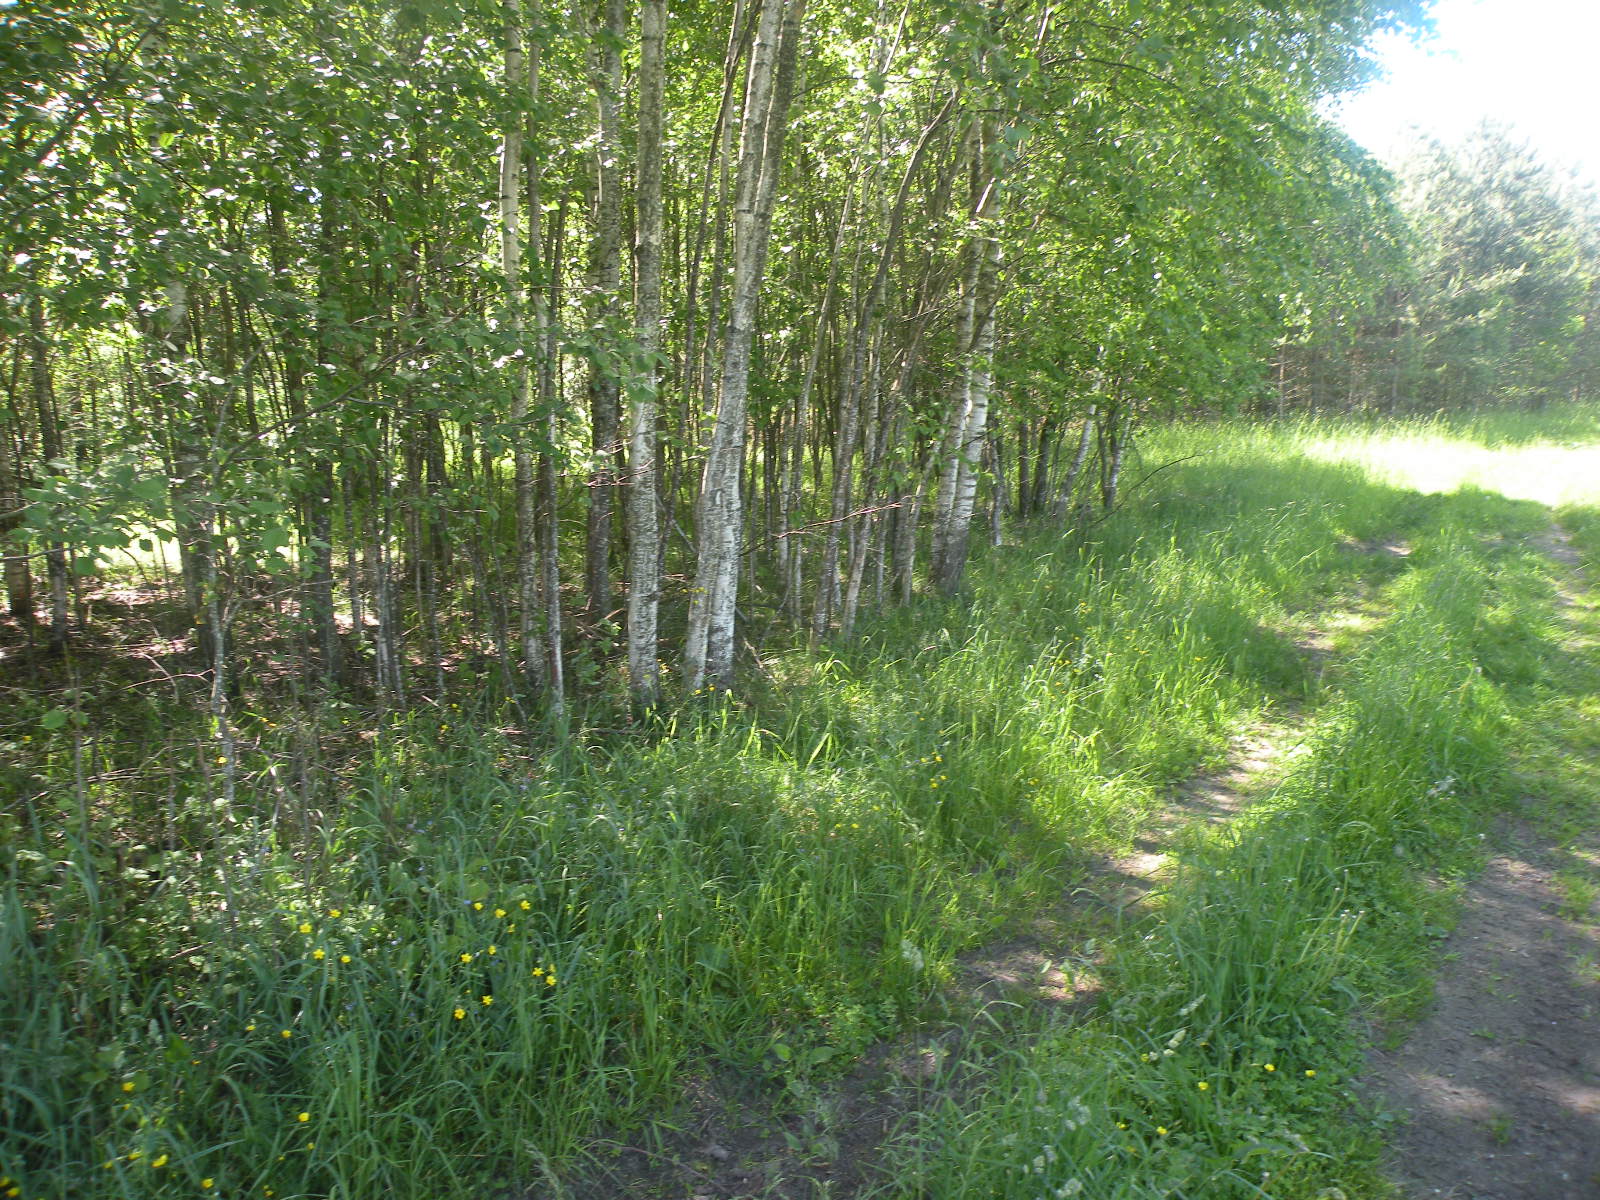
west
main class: Grassland
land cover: Grassland without tree/shrub cover
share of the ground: > 75 %
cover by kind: herbaceous plants 100 %
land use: Agriculture (excluding fallow land and kitchen gardens)
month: June
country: LV
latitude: 55.9311
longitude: 26.9548
